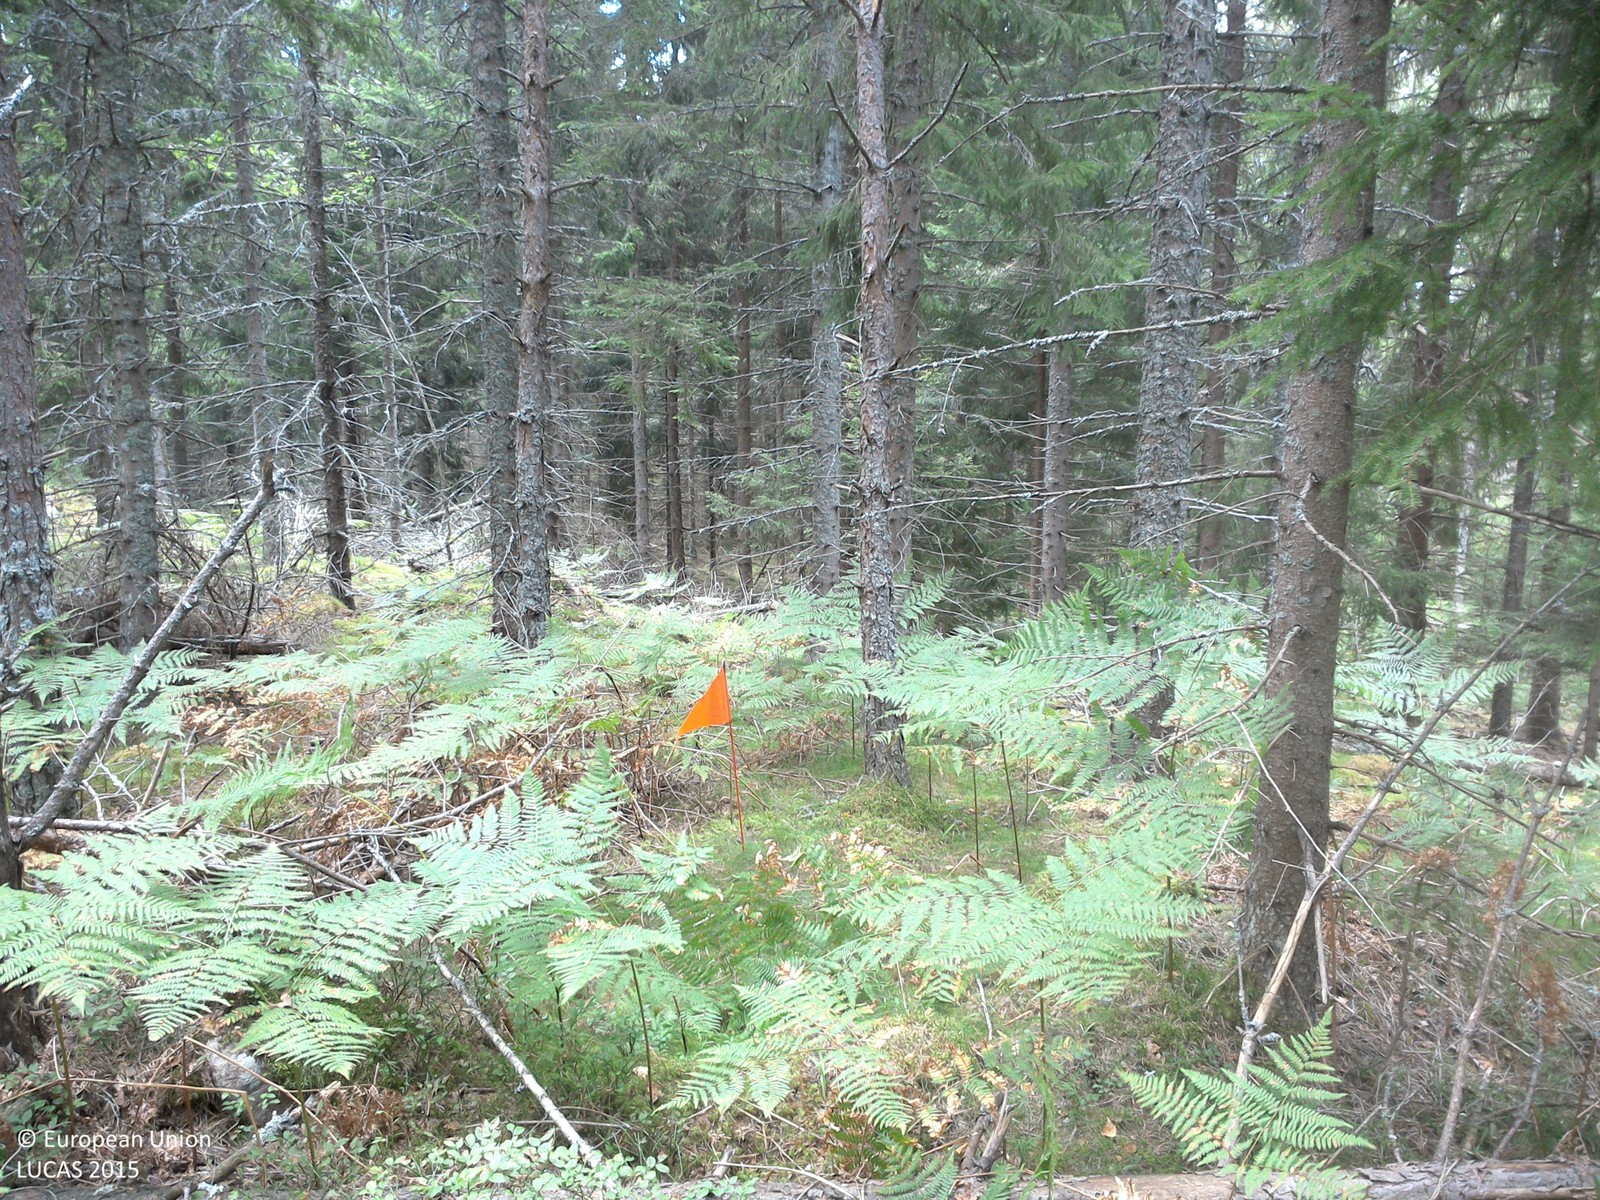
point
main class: Woodland
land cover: Spruce dominated coniferous woodland
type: boreal forest
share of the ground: 50 - 75 %
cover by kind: coniferous forest trees 60 %, herbaceous plants 30 %, lichens and mosses 10 %
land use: Forestry
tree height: > 5 m
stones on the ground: < 10 %
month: August
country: SE
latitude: 57.8888
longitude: 15.5451
